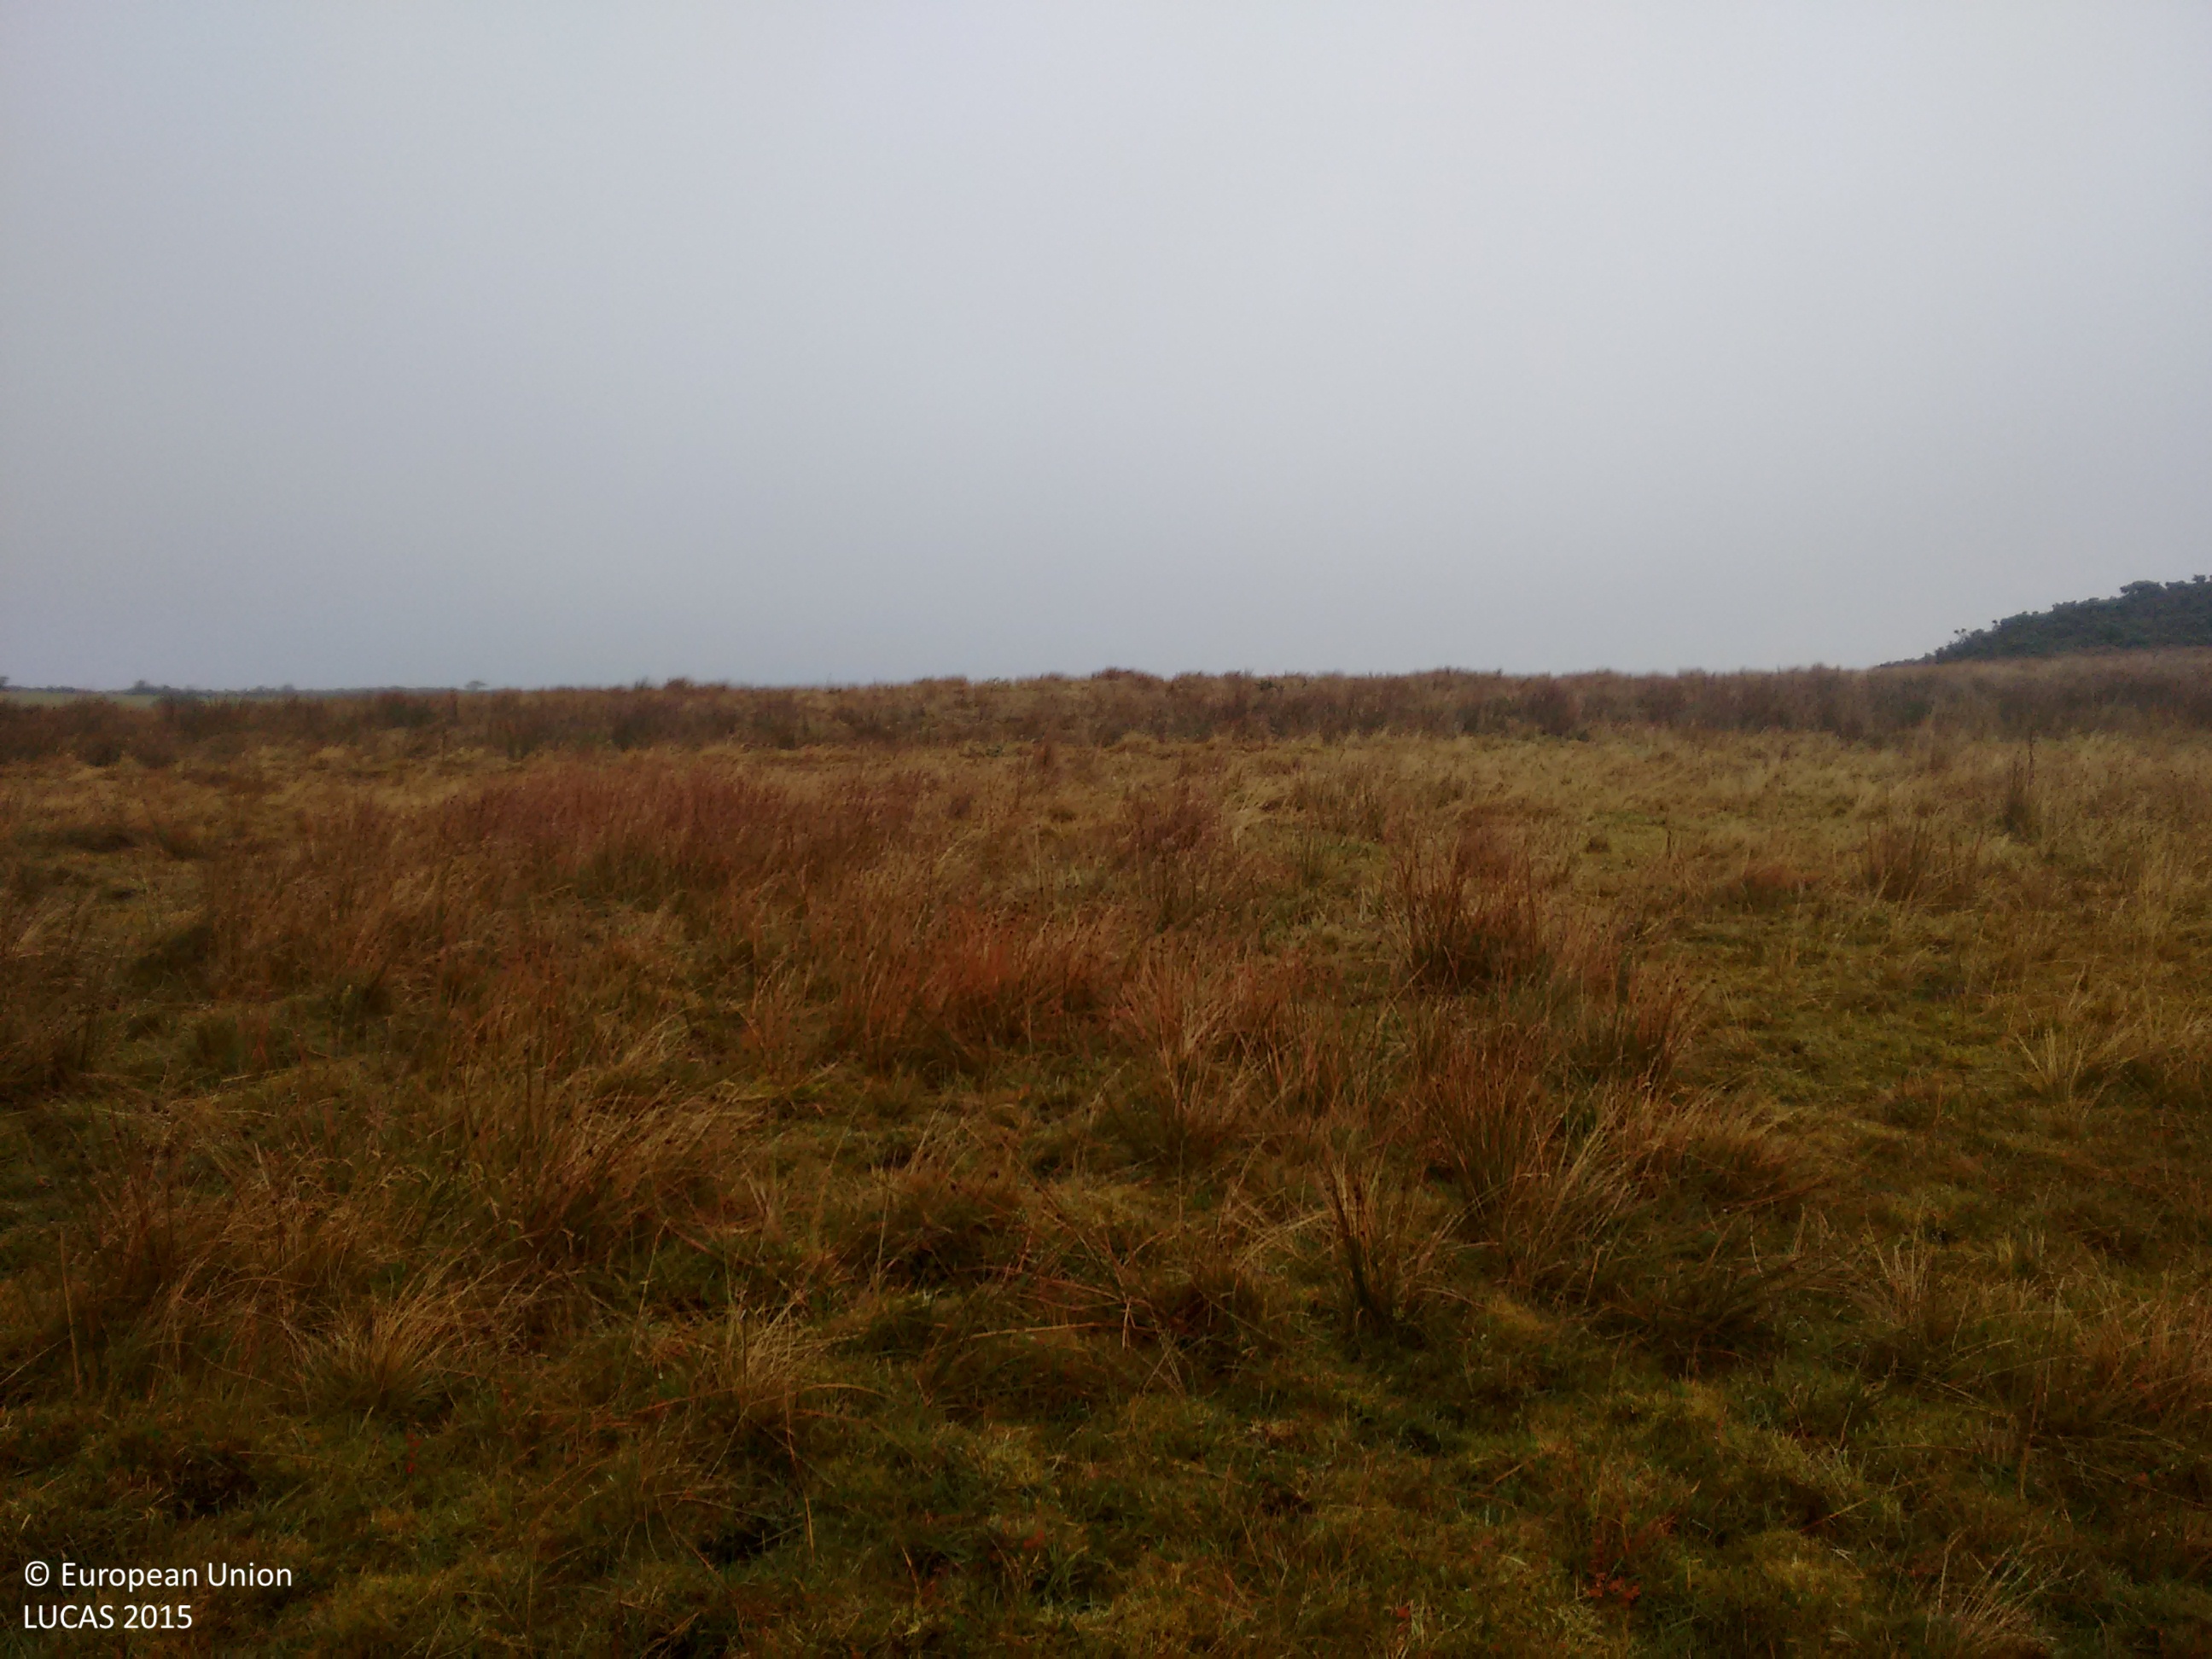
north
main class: Grassland
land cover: Grassland without tree/shrub cover
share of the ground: > 75 %
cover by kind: herbaceous plants 80 %, lichens and mosses 20 %
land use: Agriculture (excluding fallow land and kitchen gardens)
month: October
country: GB
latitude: 55.7441
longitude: -6.2814
